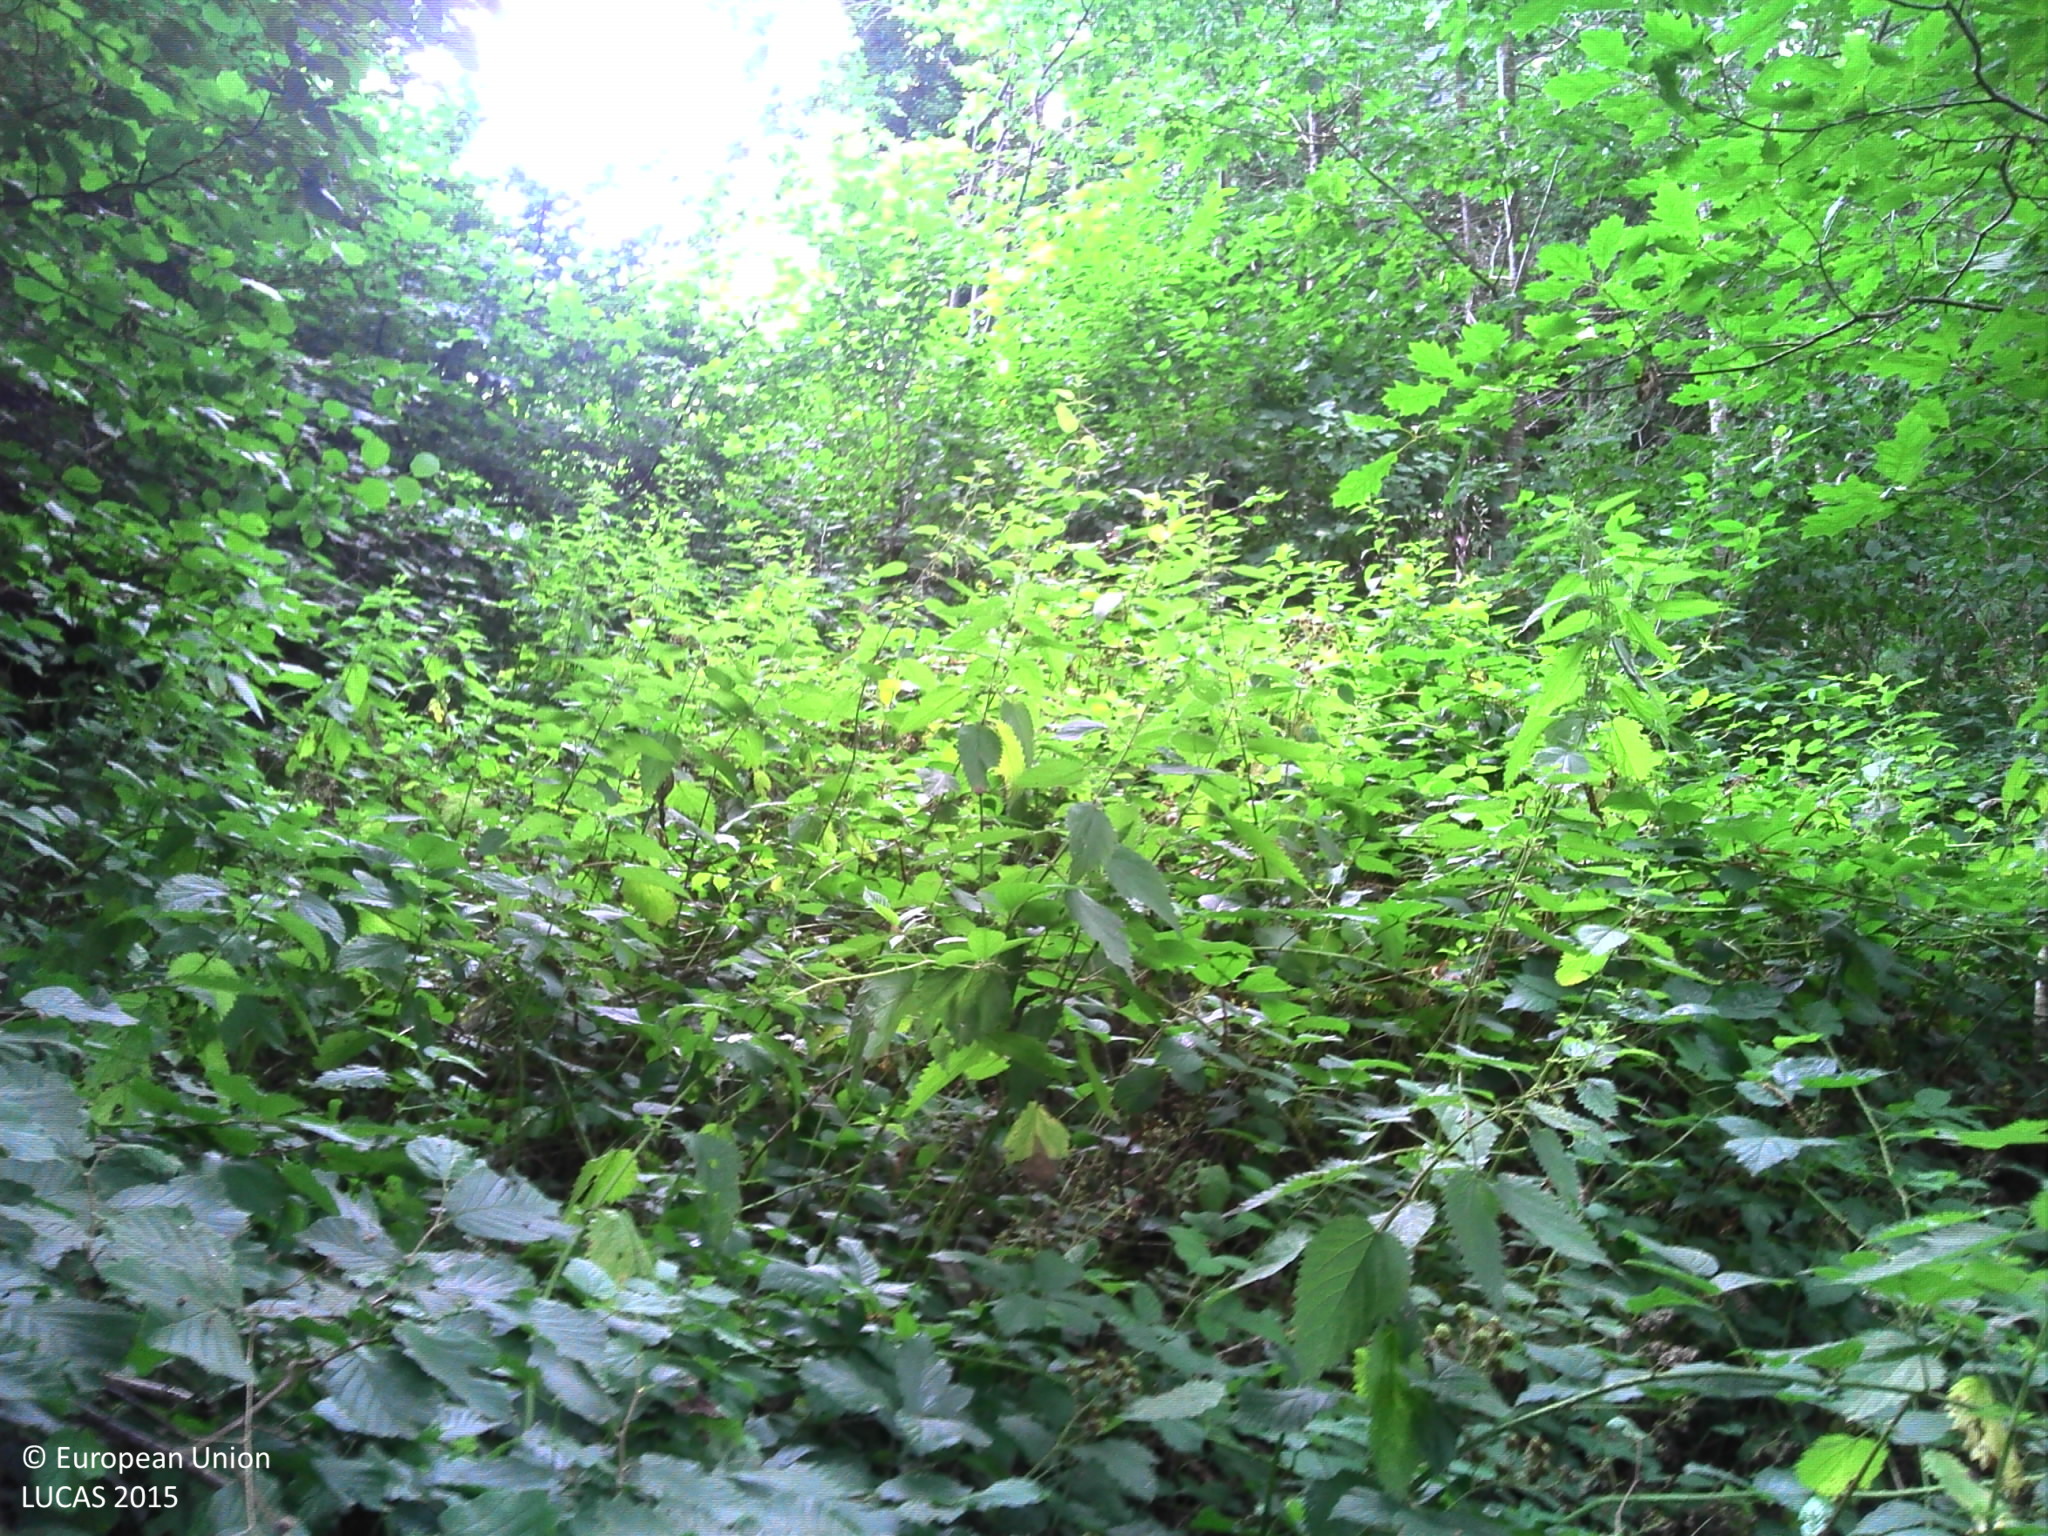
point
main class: Woodland
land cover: Broadleaved woodland
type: acidophilous oak and oak-birch forest
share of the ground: > 75 %
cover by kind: broadleaved forest trees 70 %, shrubs 20 %, herbaceous plants 10 %
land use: Semi-natural and natural areas not in use
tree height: > 5 m
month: August
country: FR
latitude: 48.4205
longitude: -3.4140
